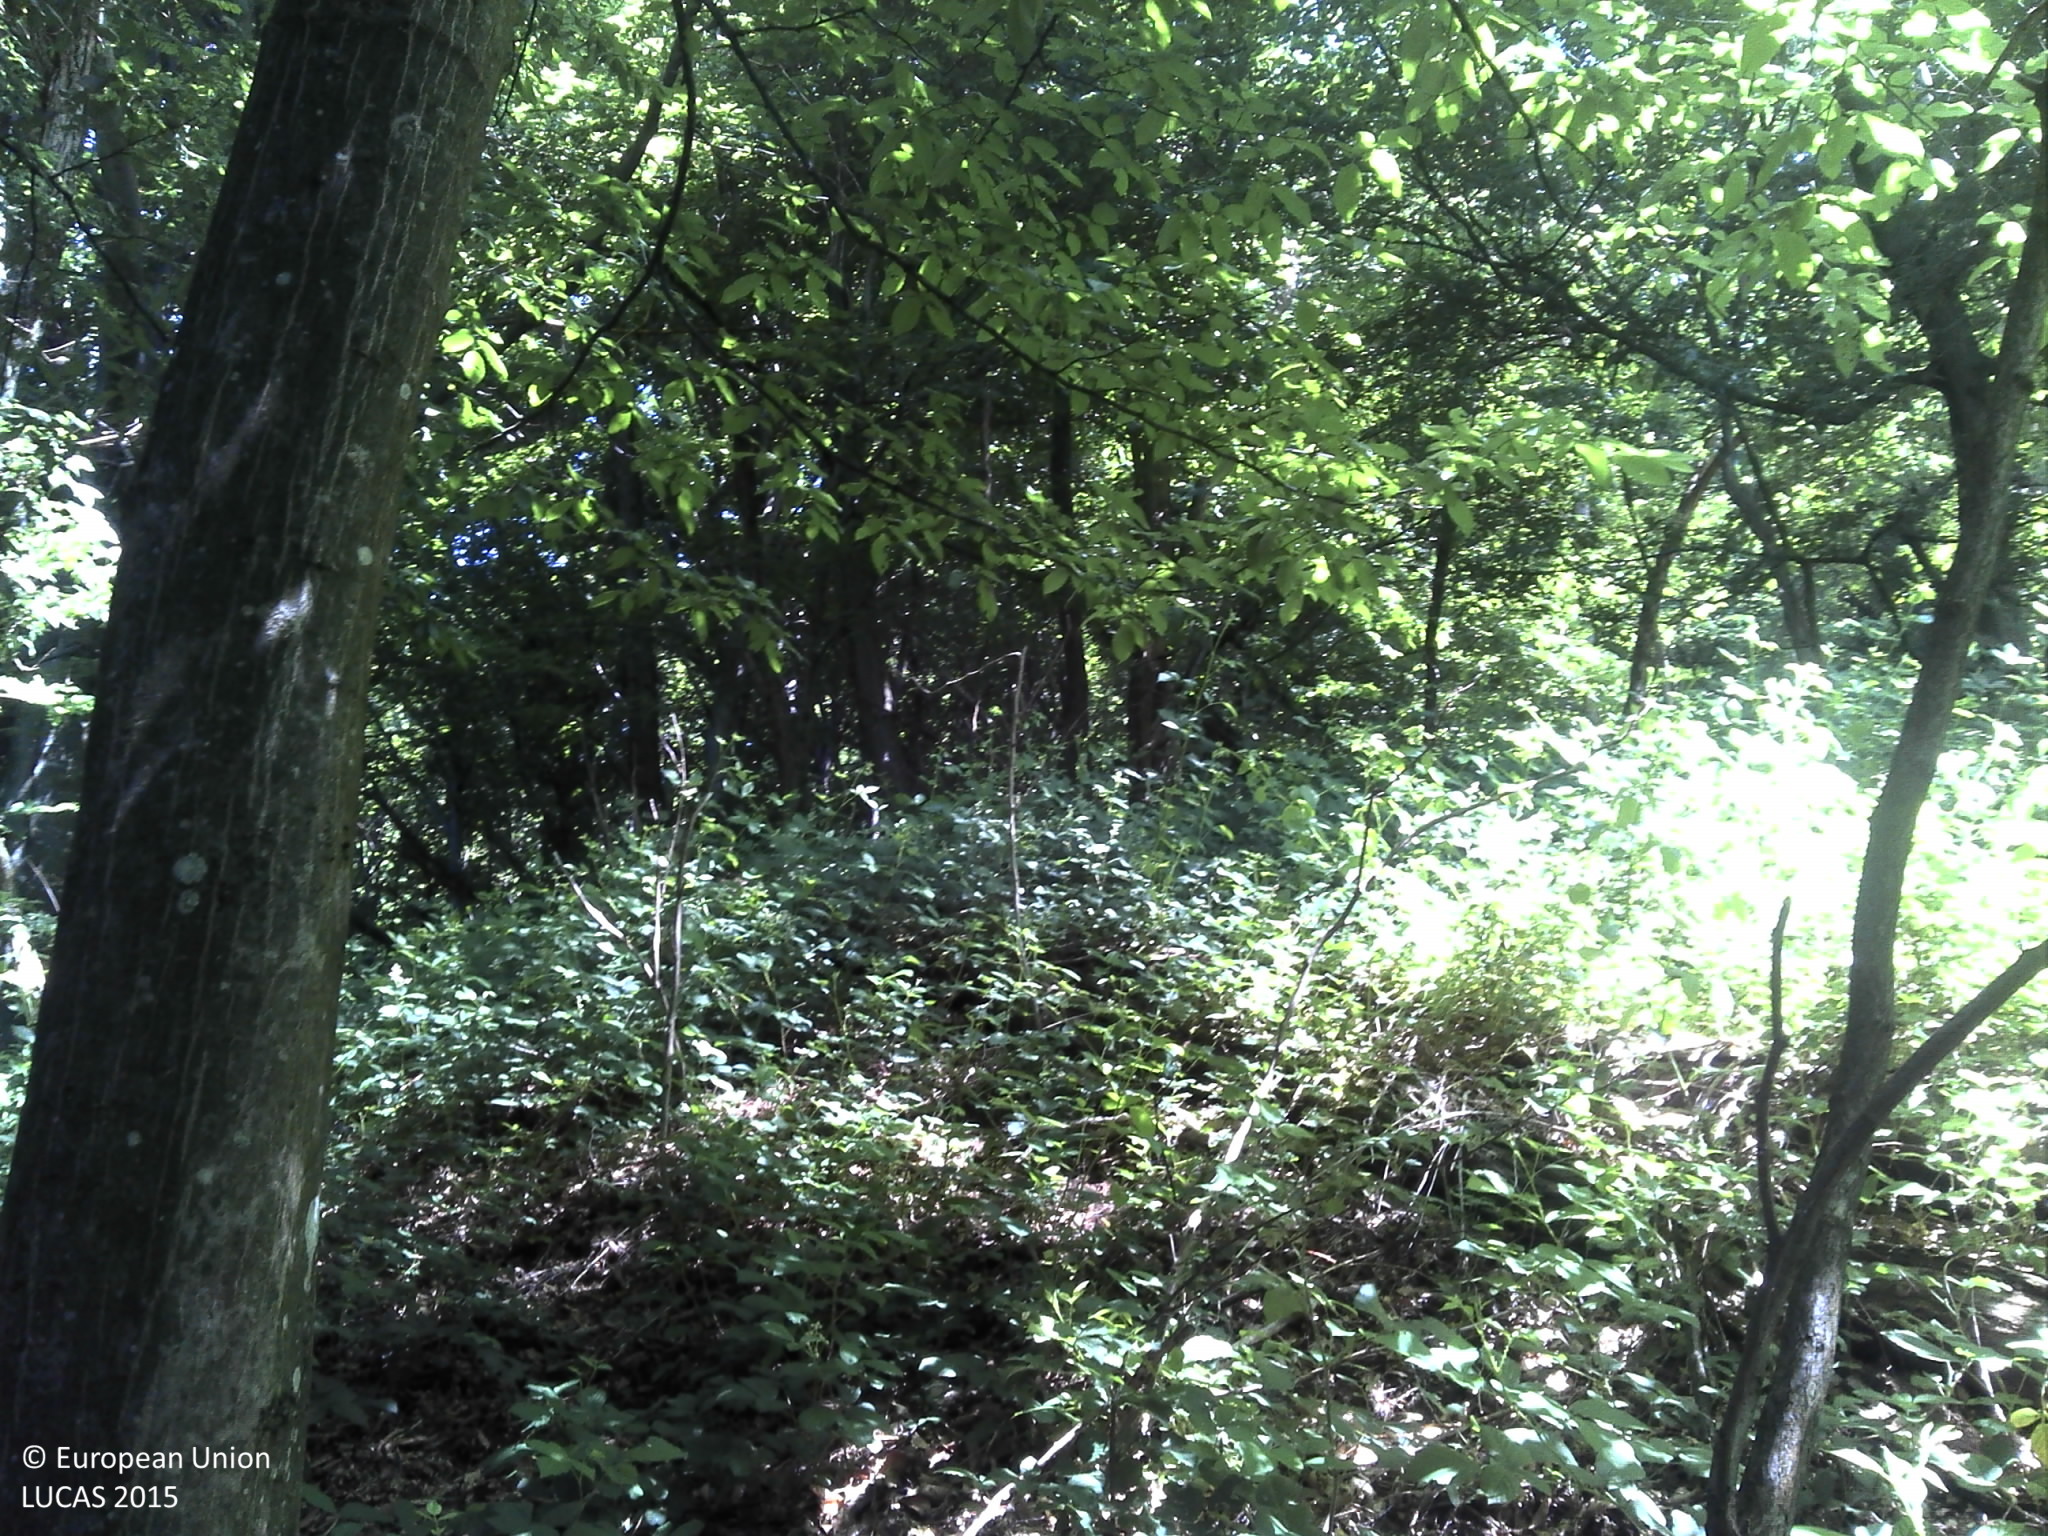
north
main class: Woodland
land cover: Broadleaved woodland
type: acidophilous oak and oak-birch forest
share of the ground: > 75 %
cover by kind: broadleaved forest trees 80 %, lichens and mosses 20 %
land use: Forestry
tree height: > 5 m
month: June
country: HR
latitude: 45.4676
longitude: 17.8176
